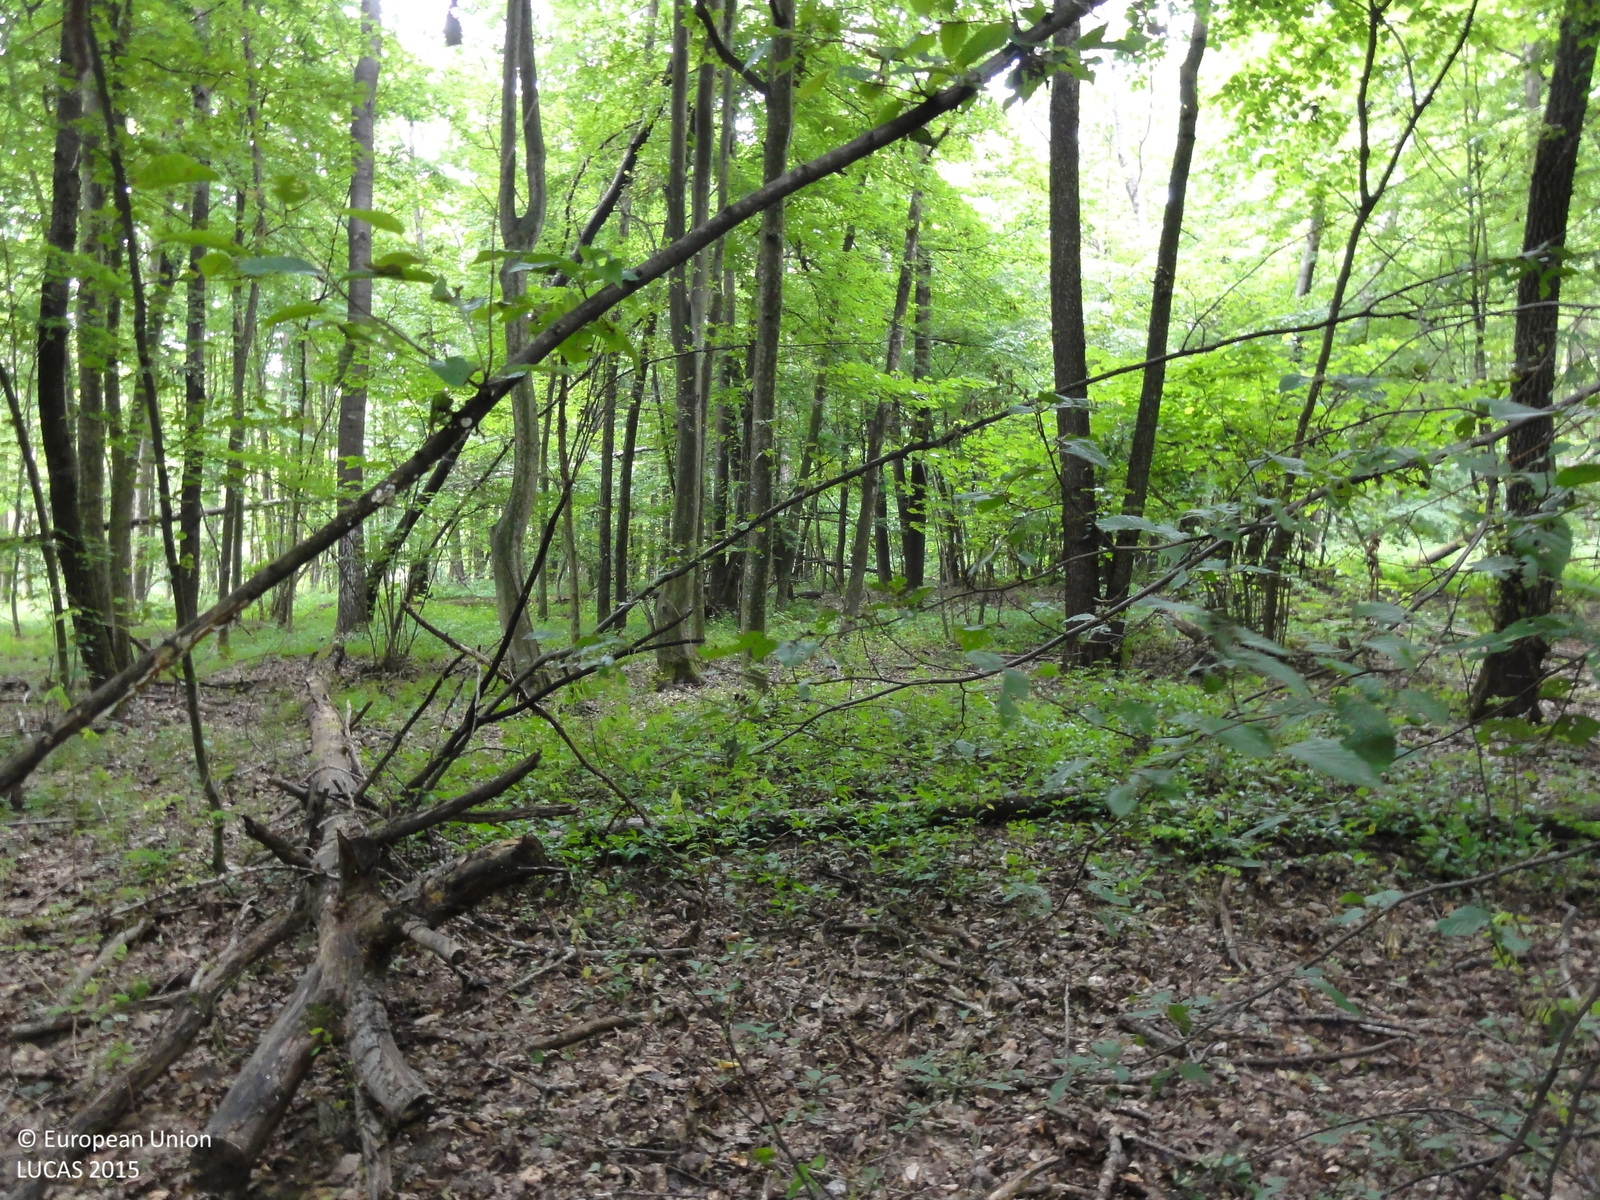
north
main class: Woodland
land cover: Broadleaved woodland
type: mesophytic deciduous forest
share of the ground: > 75 %
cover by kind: broadleaved forest trees 100 %
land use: Forestry
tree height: > 5 m
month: June
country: SI
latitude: 46.7317
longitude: 16.1905
